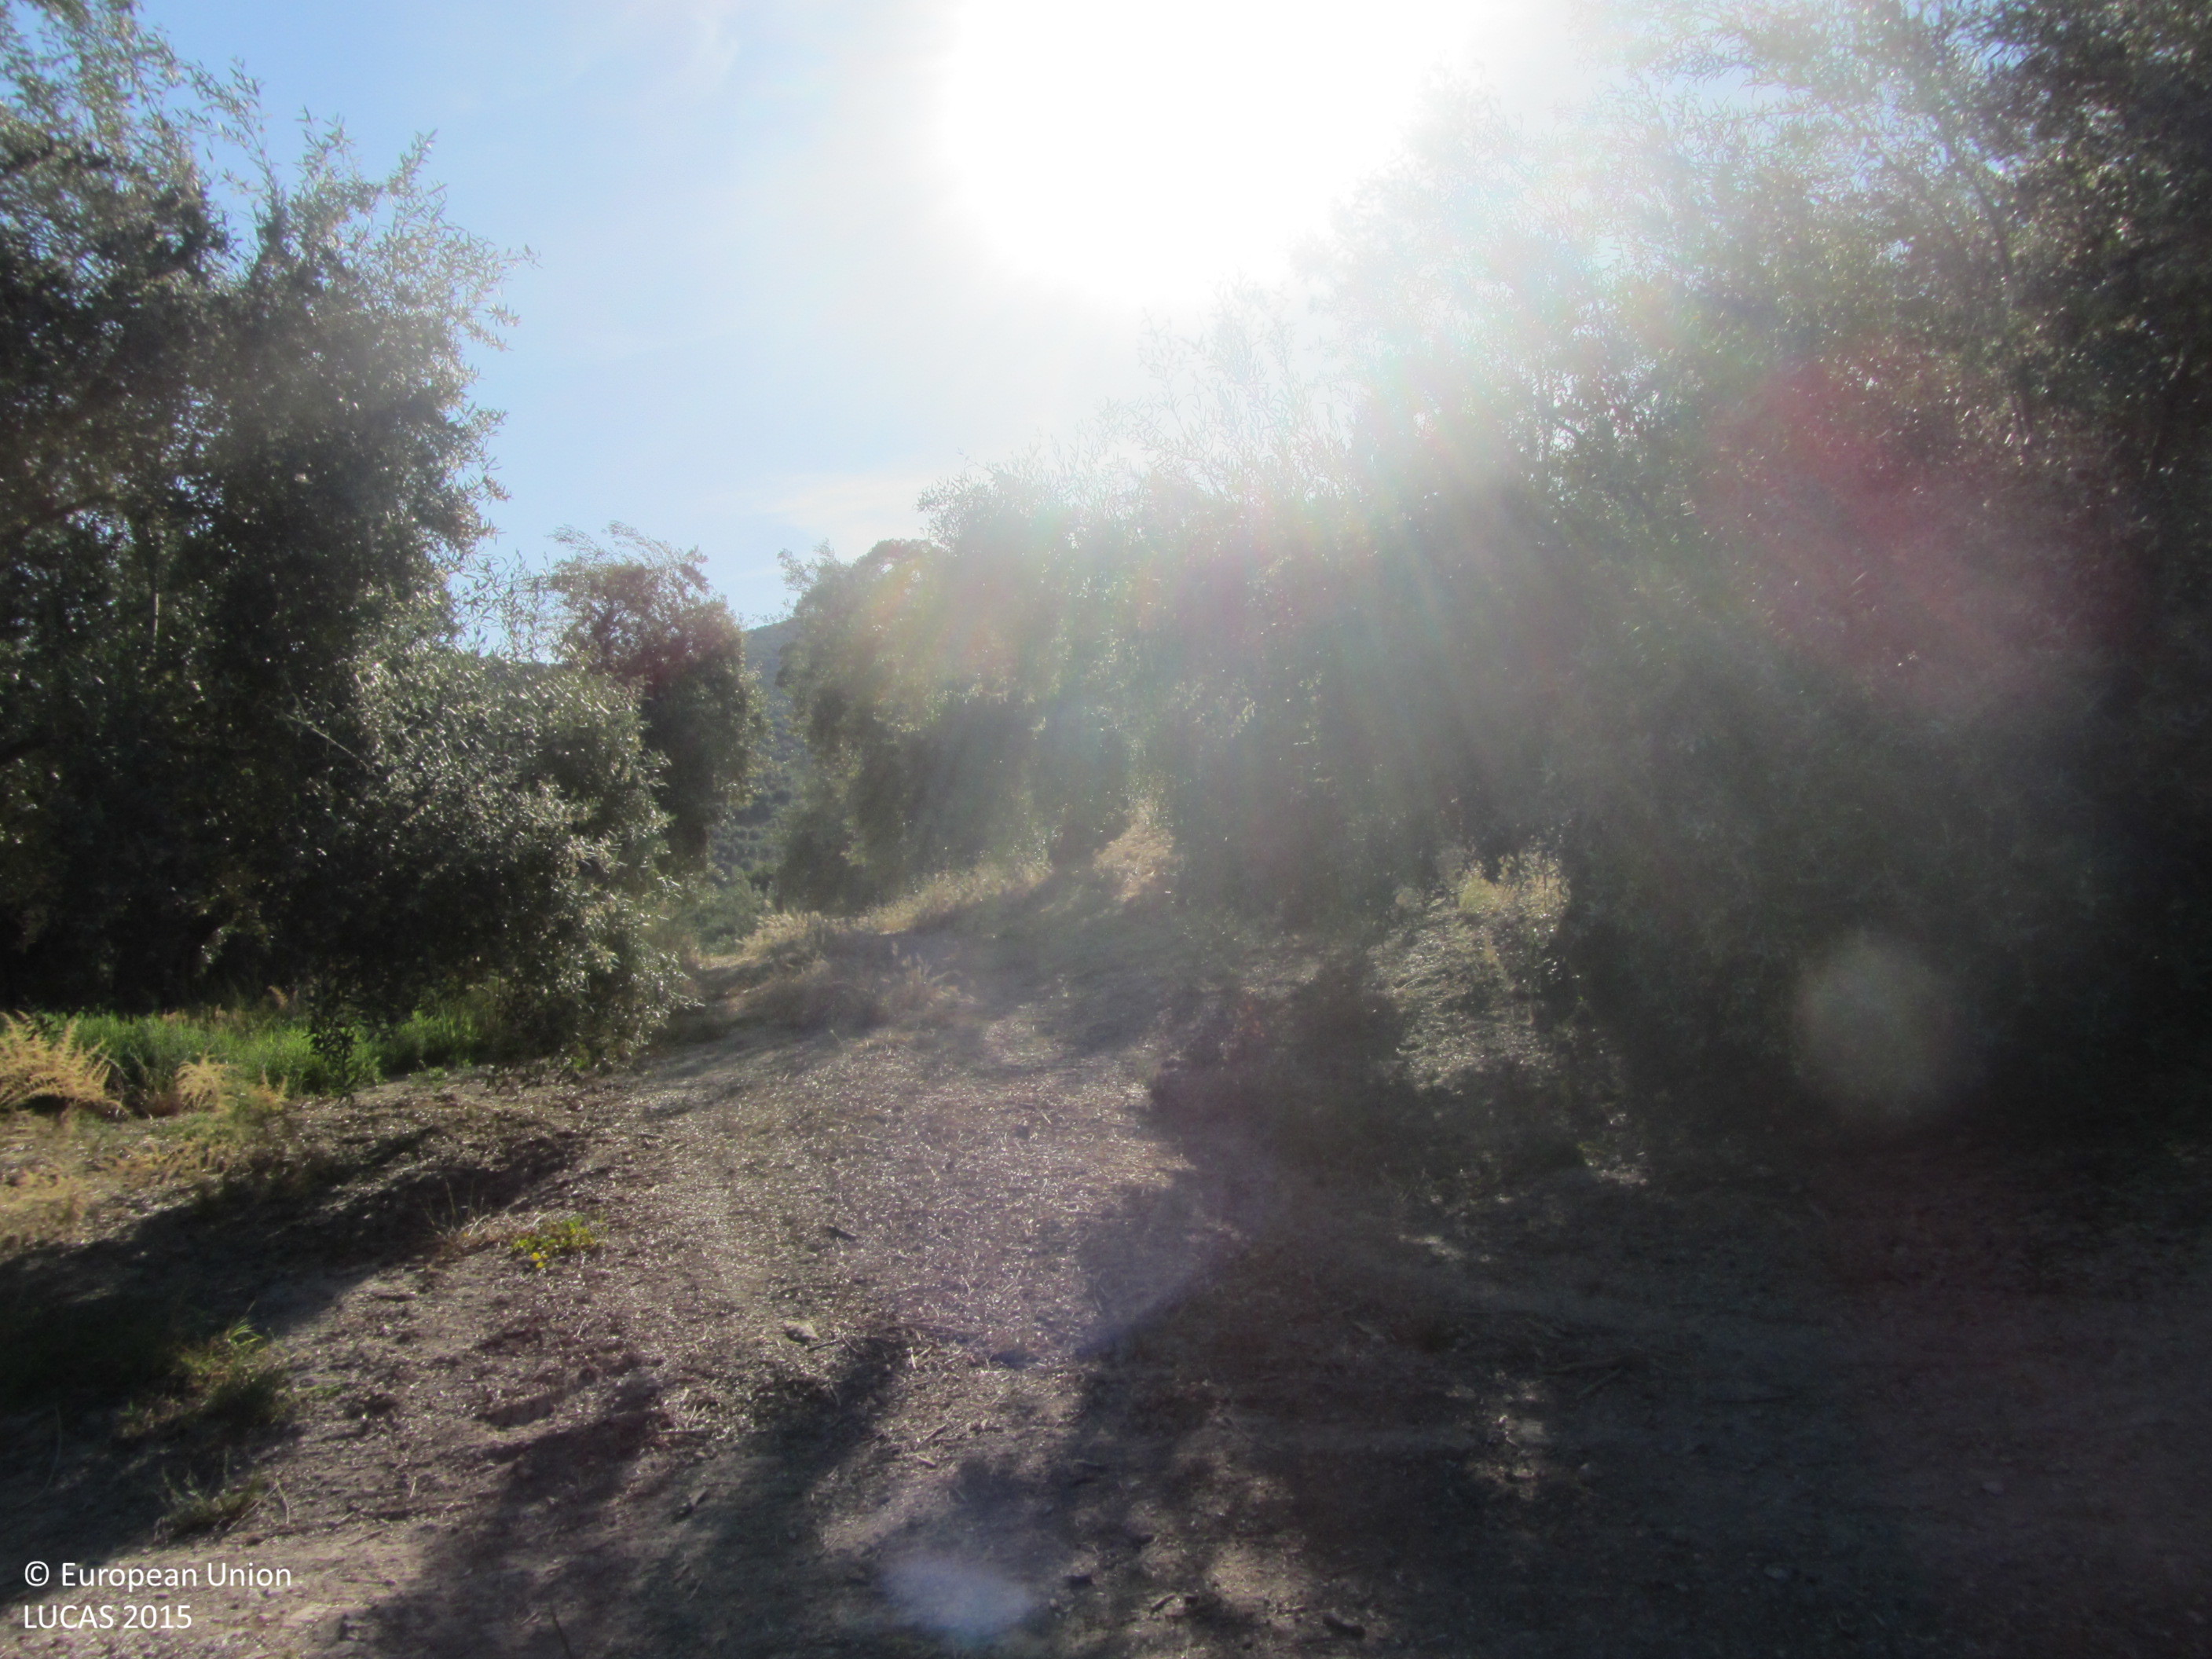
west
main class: Cropland
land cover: Olive groves
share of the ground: 25 - 50 %
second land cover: Other bare soil
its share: > 75 %
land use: Agriculture (excluding fallow land and kitchen gardens)
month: May
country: ES
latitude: 38.1177
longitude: -2.9897
